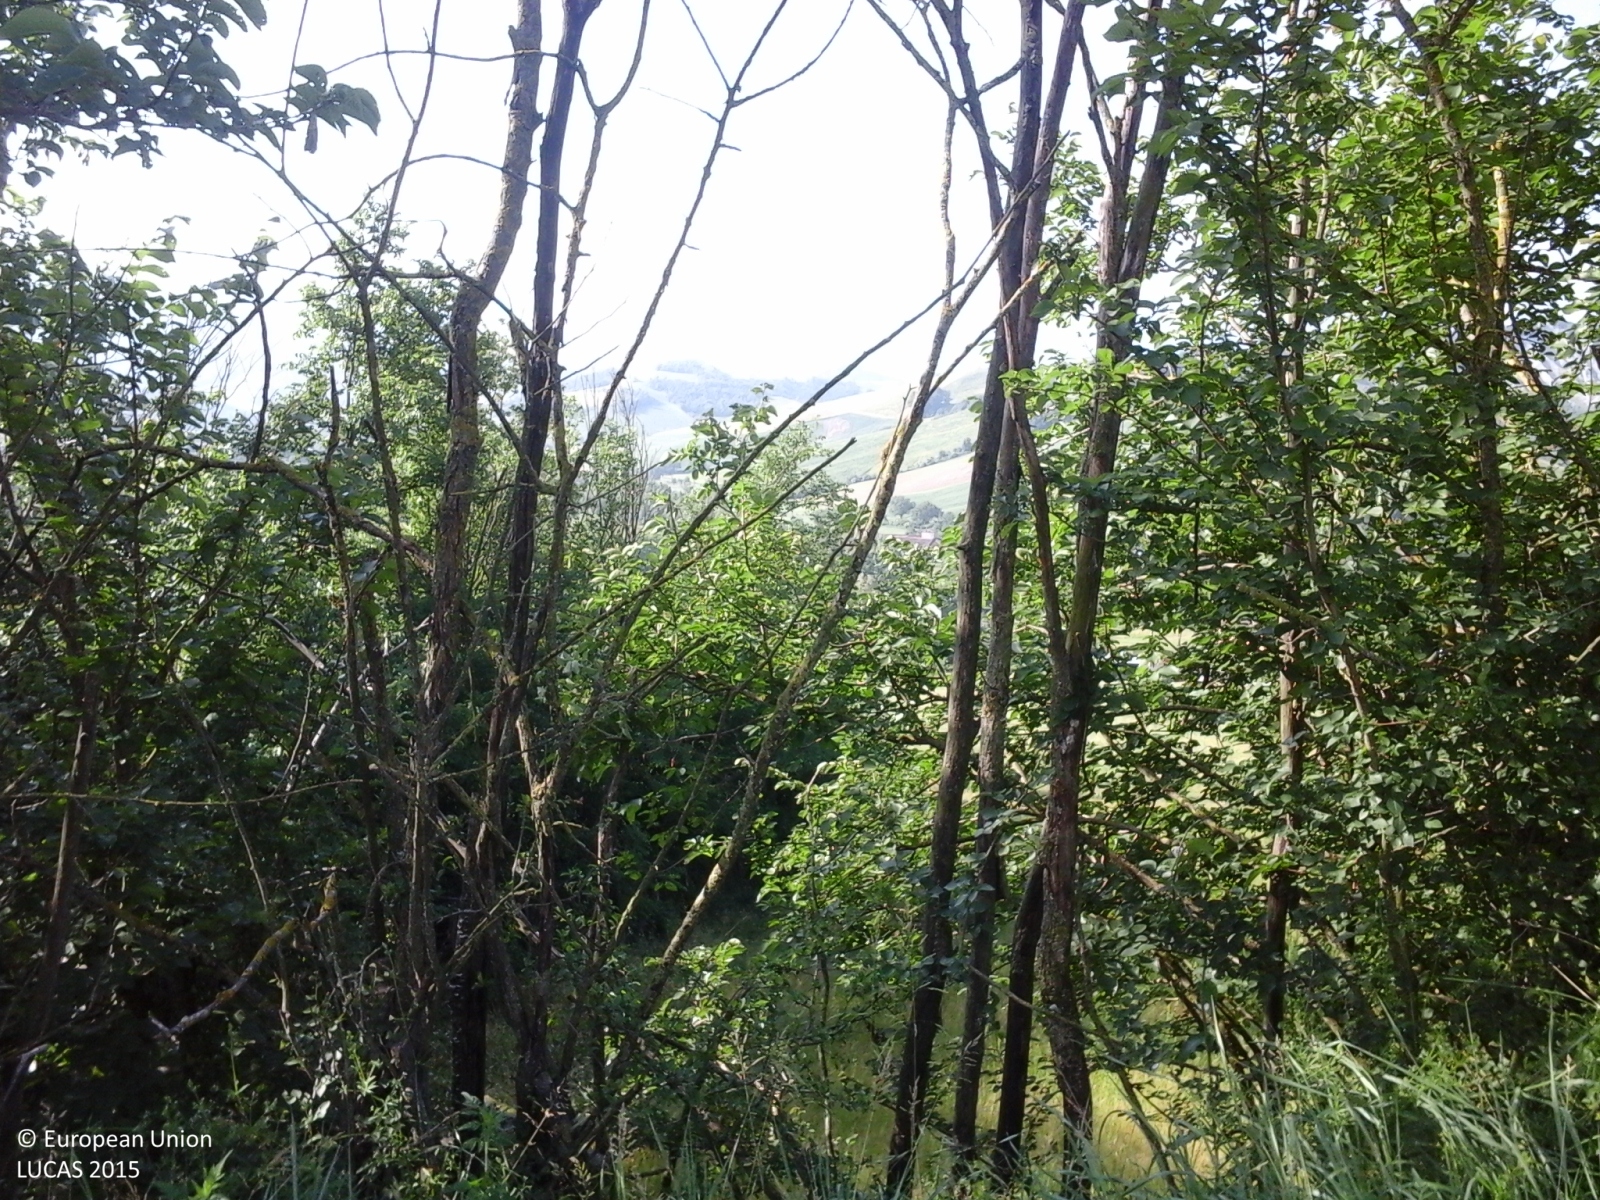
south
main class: Grassland
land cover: Grassland without tree/shrub cover
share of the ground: > 75 %
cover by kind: herbaceous plants 100 %
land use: Agriculture (excluding fallow land and kitchen gardens)
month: May
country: IT
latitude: 44.6751
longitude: 10.1133
